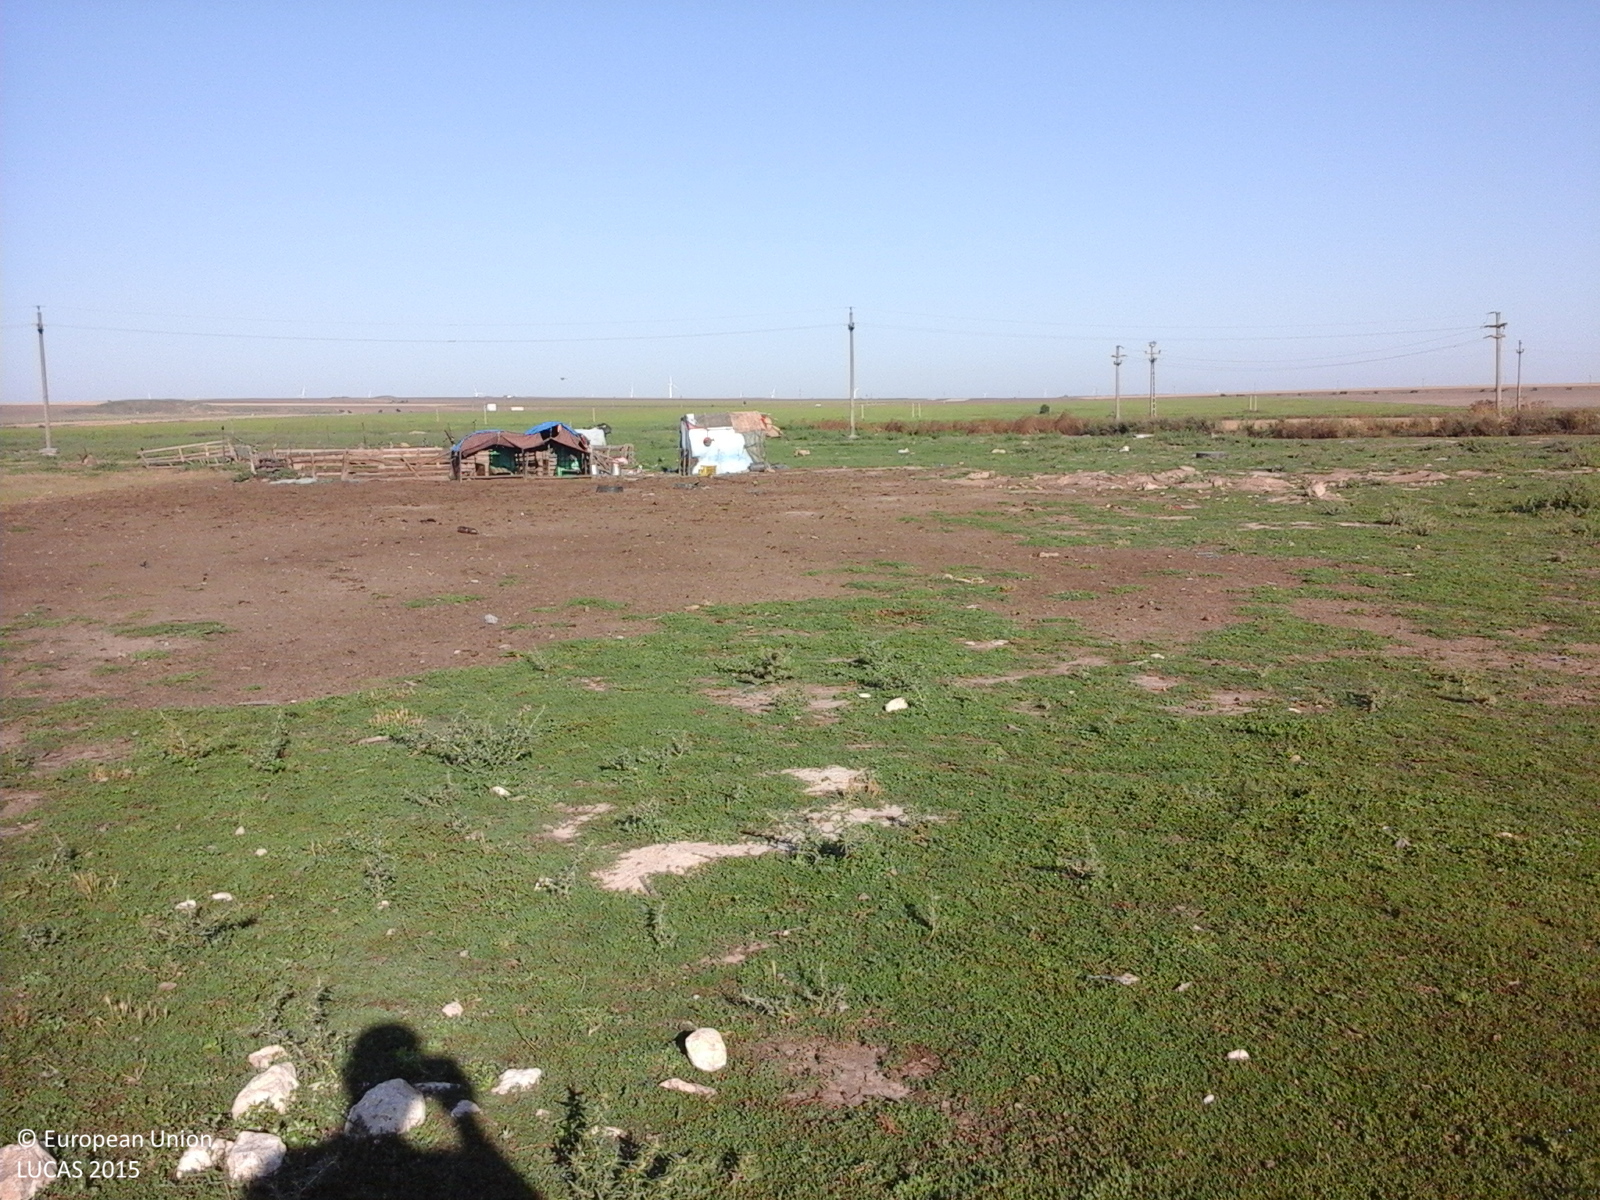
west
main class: Grassland
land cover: Grassland without tree/shrub cover
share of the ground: > 75 %
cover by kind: herbaceous plants 100 %
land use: Agriculture (excluding fallow land and kitchen gardens)
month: August
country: RO
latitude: 44.3585
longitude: 28.4509
